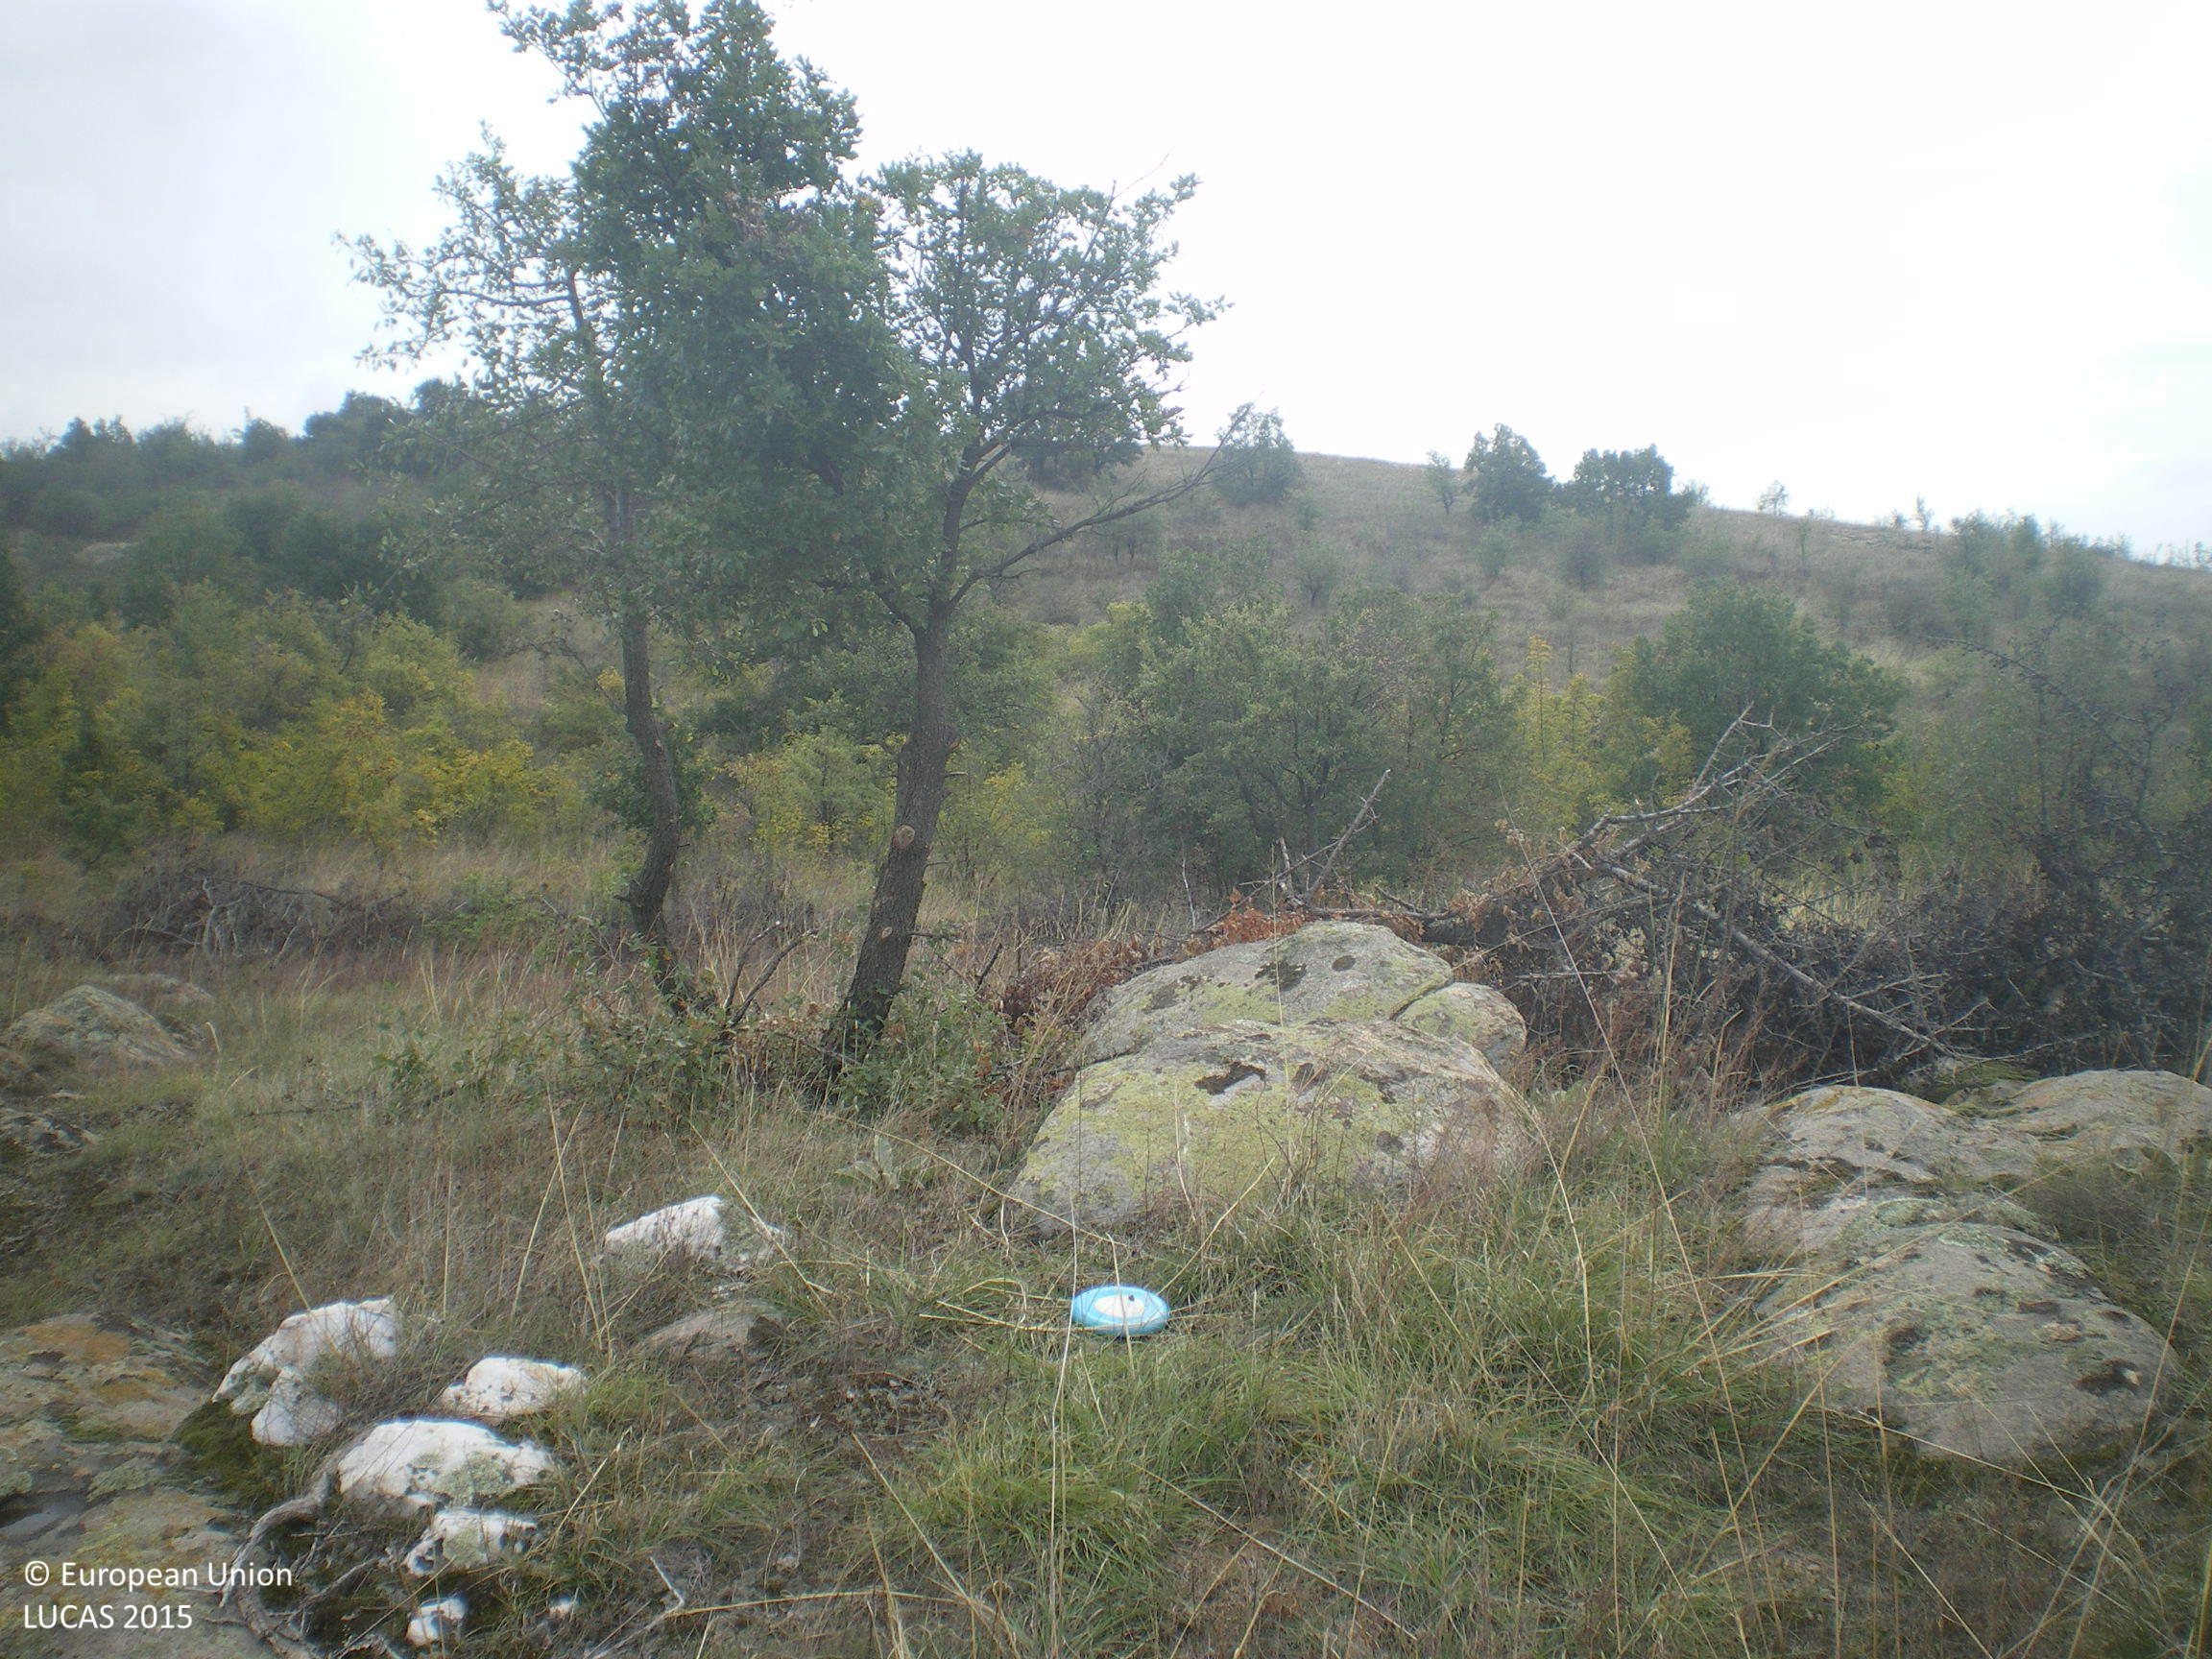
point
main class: Grassland
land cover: Grassland with sparse tree/shrub cover
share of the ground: > 75 %
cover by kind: herbaceous plants 85 %, shrubs 10 %, broadleaved forest trees 5 %
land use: Agriculture (excluding fallow land and kitchen gardens)
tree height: > 5 m
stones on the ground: < 10 %
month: October
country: BG
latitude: 41.9723
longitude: 26.0404
